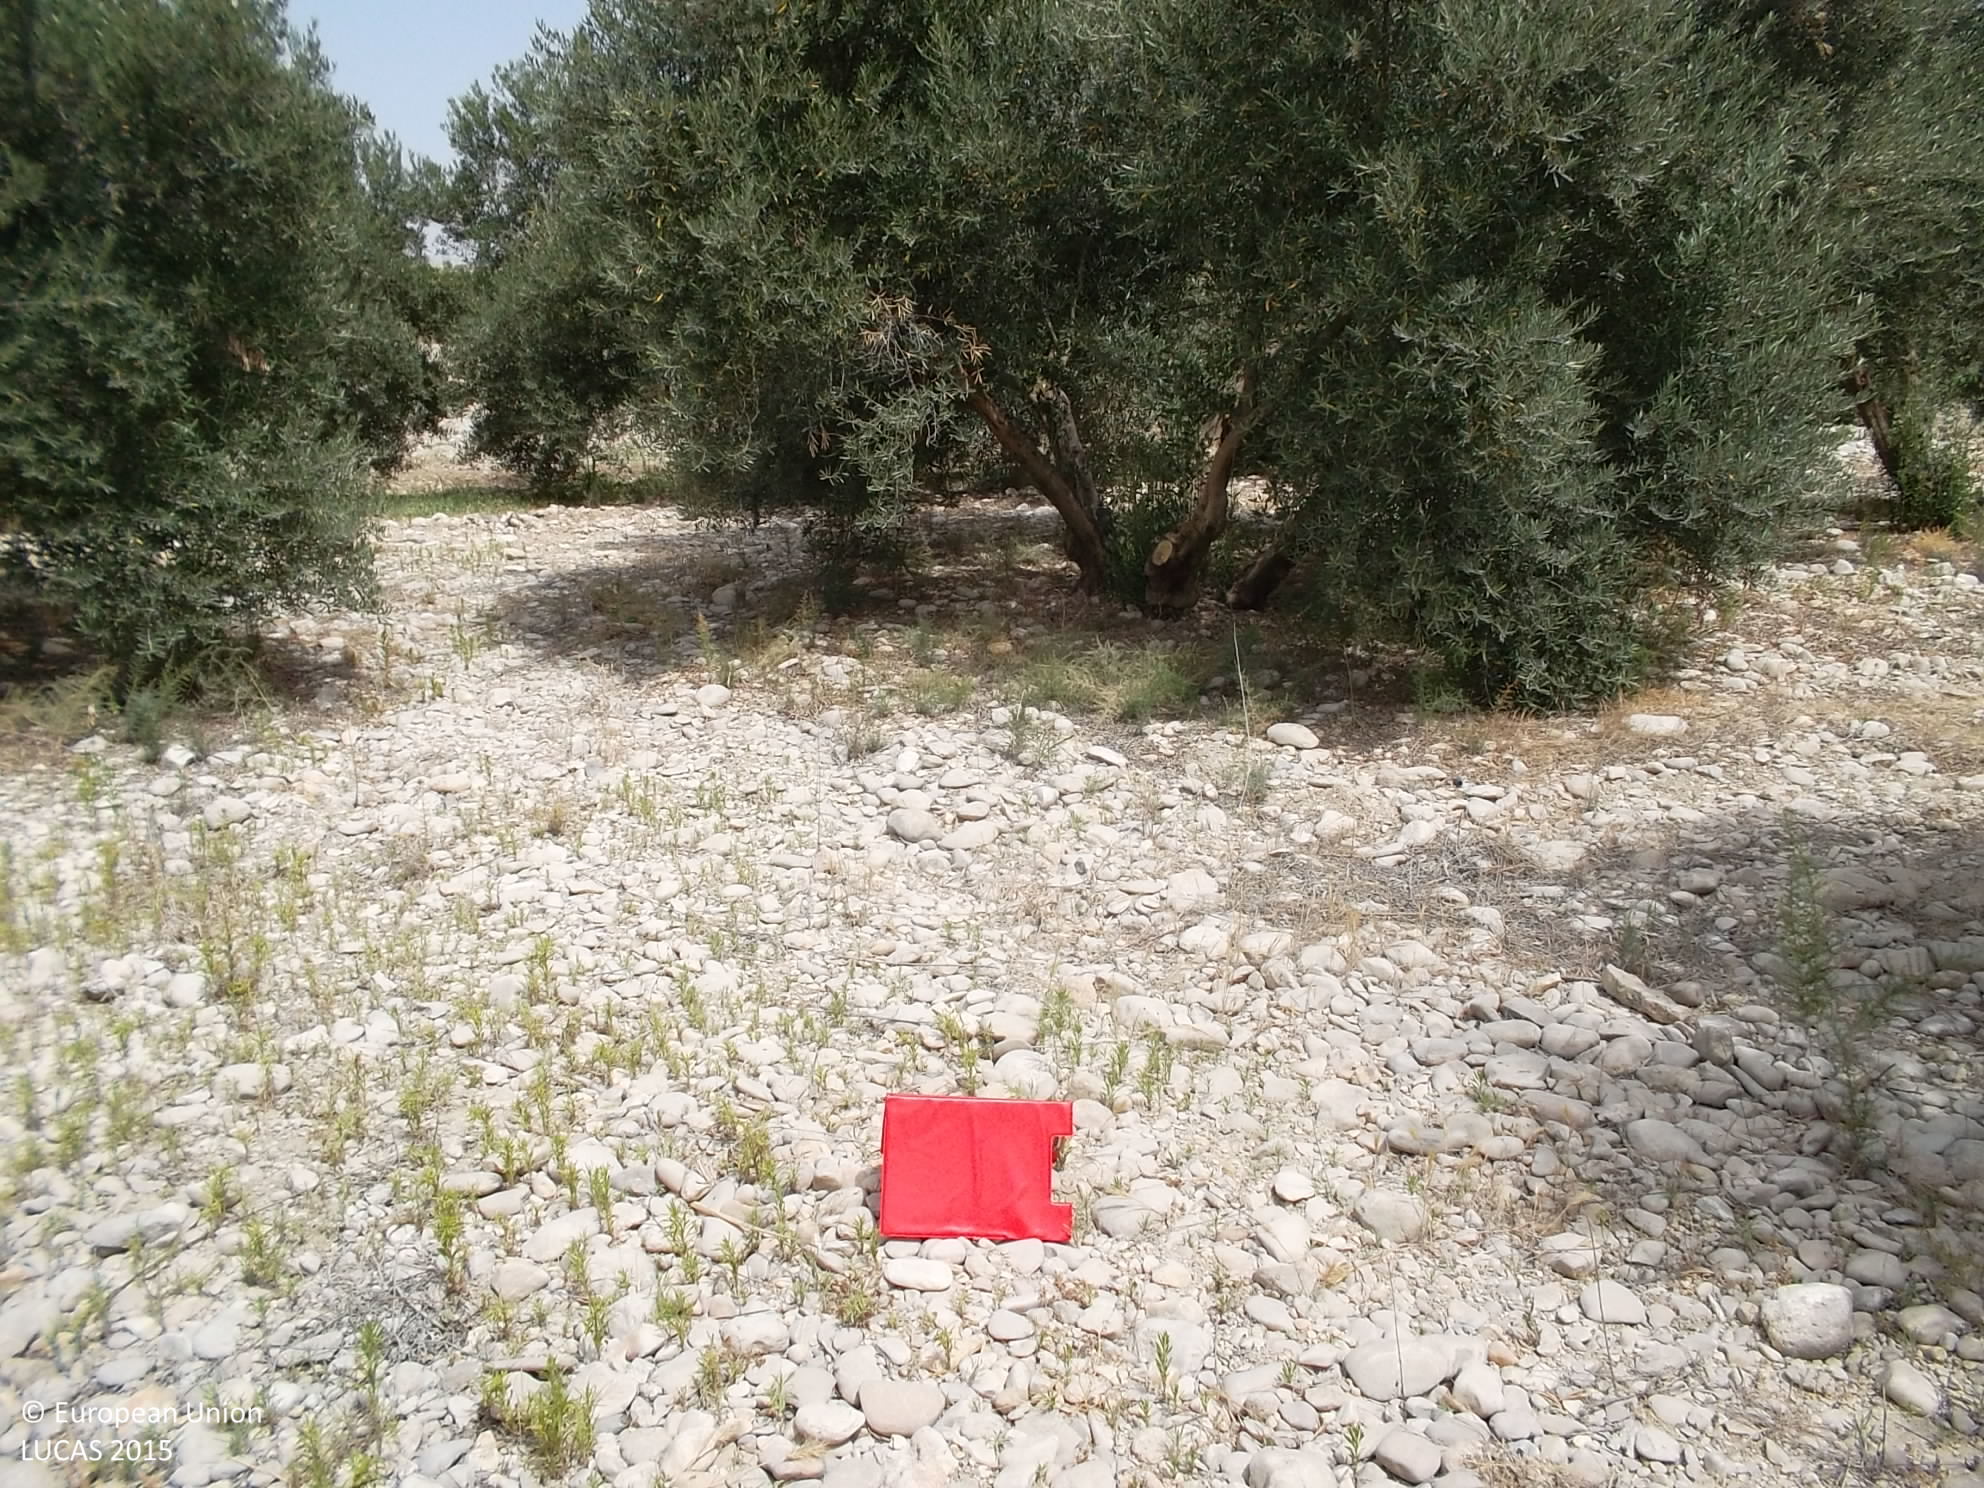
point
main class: Cropland
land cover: Olive groves
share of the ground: 50 - 75 %
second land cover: Other bare soil
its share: > 75 %
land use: Agriculture (excluding fallow land and kitchen gardens)
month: July
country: ES
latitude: 37.6001
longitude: -2.7537
